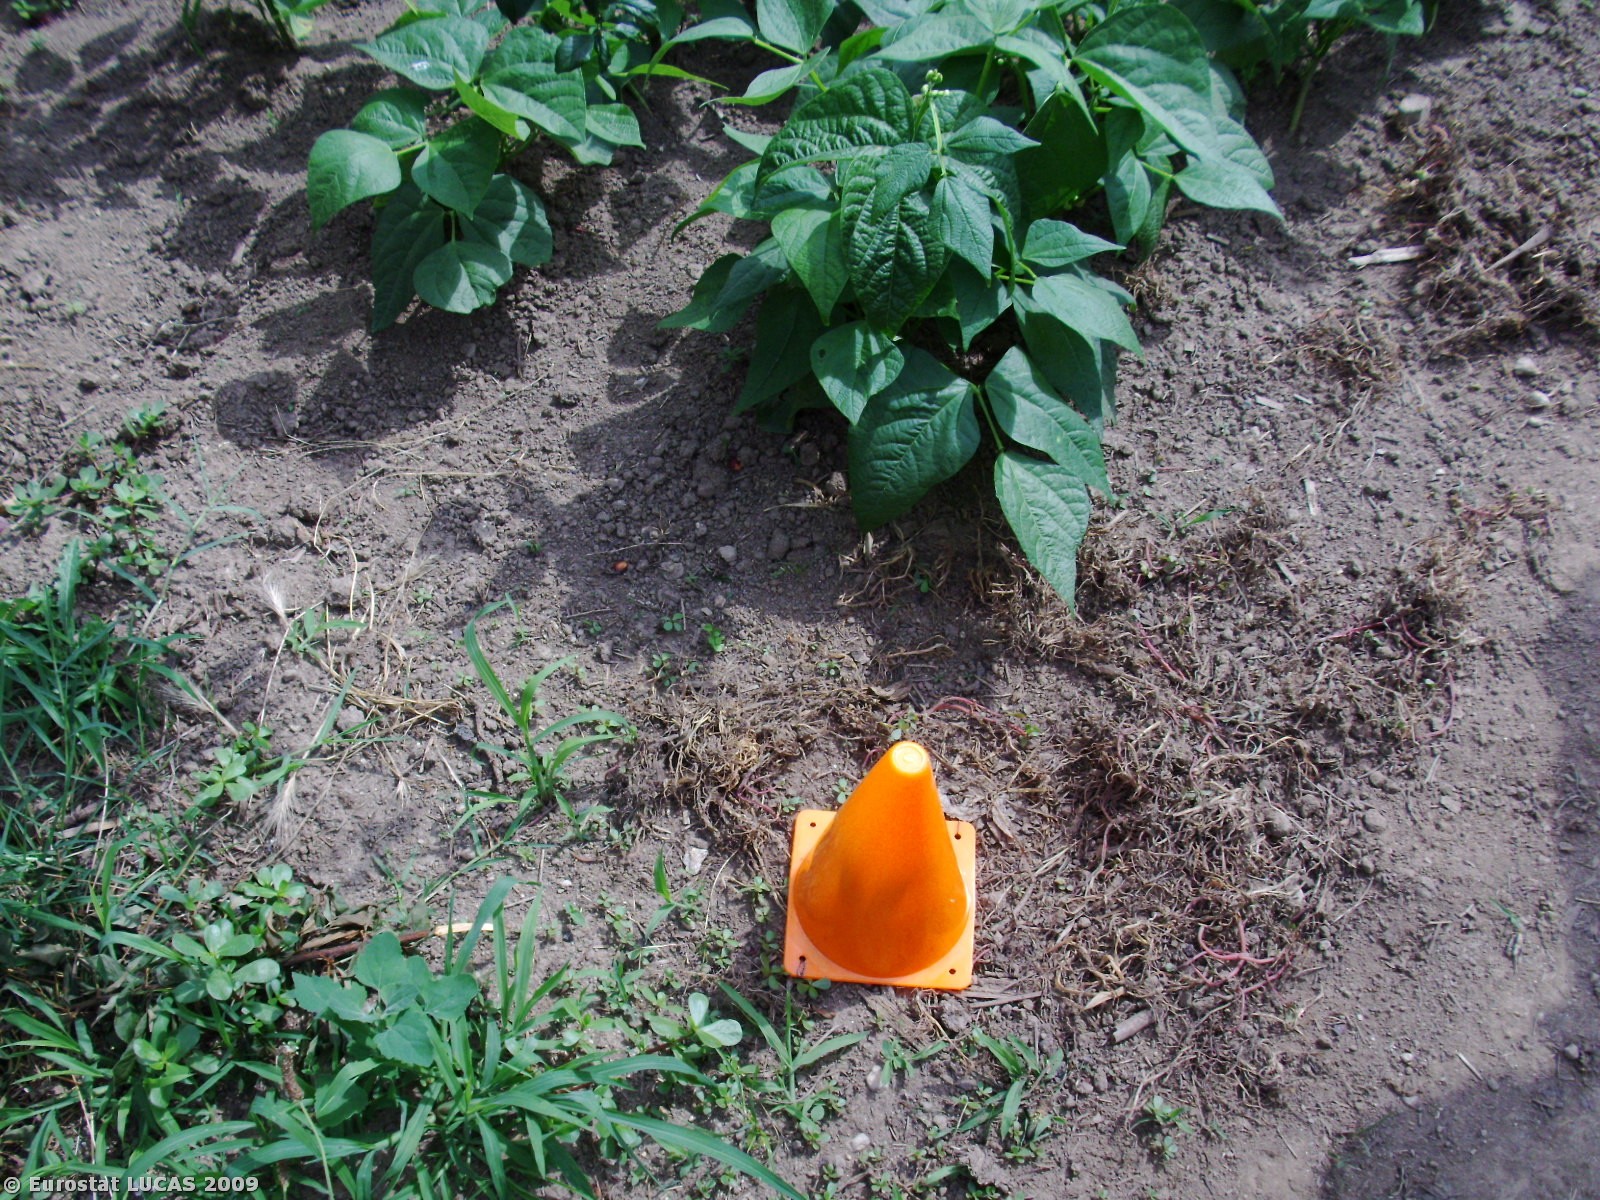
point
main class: Cropland
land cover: Potatoes
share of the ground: 50 - 75 %
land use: Agriculture (excluding fallow land and kitchen gardens)
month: June
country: PT
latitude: 41.4007
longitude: -8.4652
